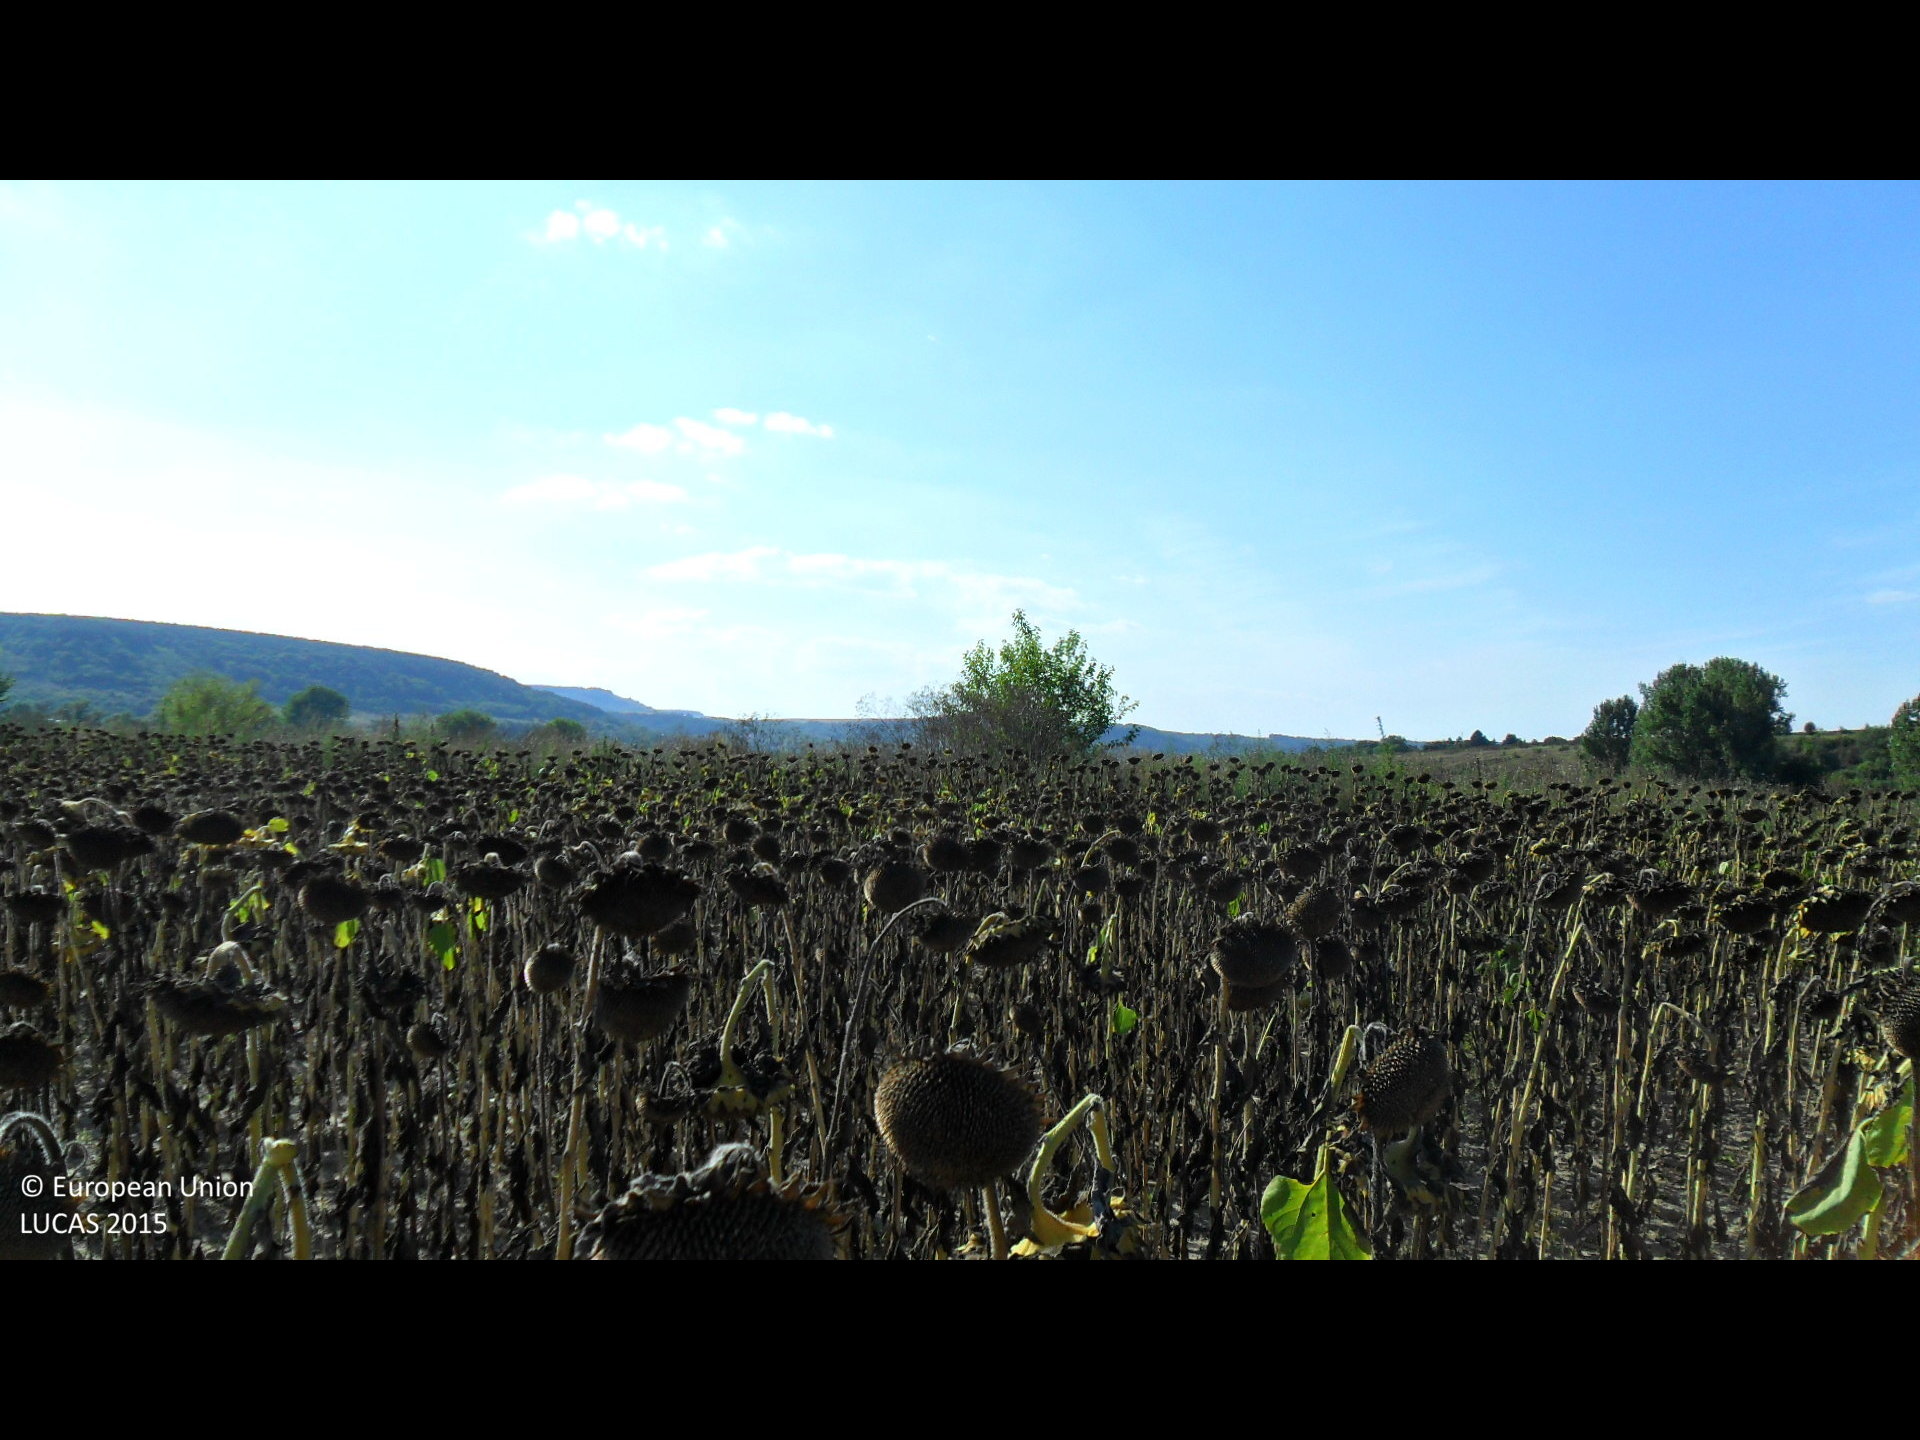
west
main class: Cropland
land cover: Sunflower
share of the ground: > 75 %
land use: Agriculture (excluding fallow land and kitchen gardens)
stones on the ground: < 10 %
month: August
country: BG
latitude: 43.4728
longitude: 26.3061
